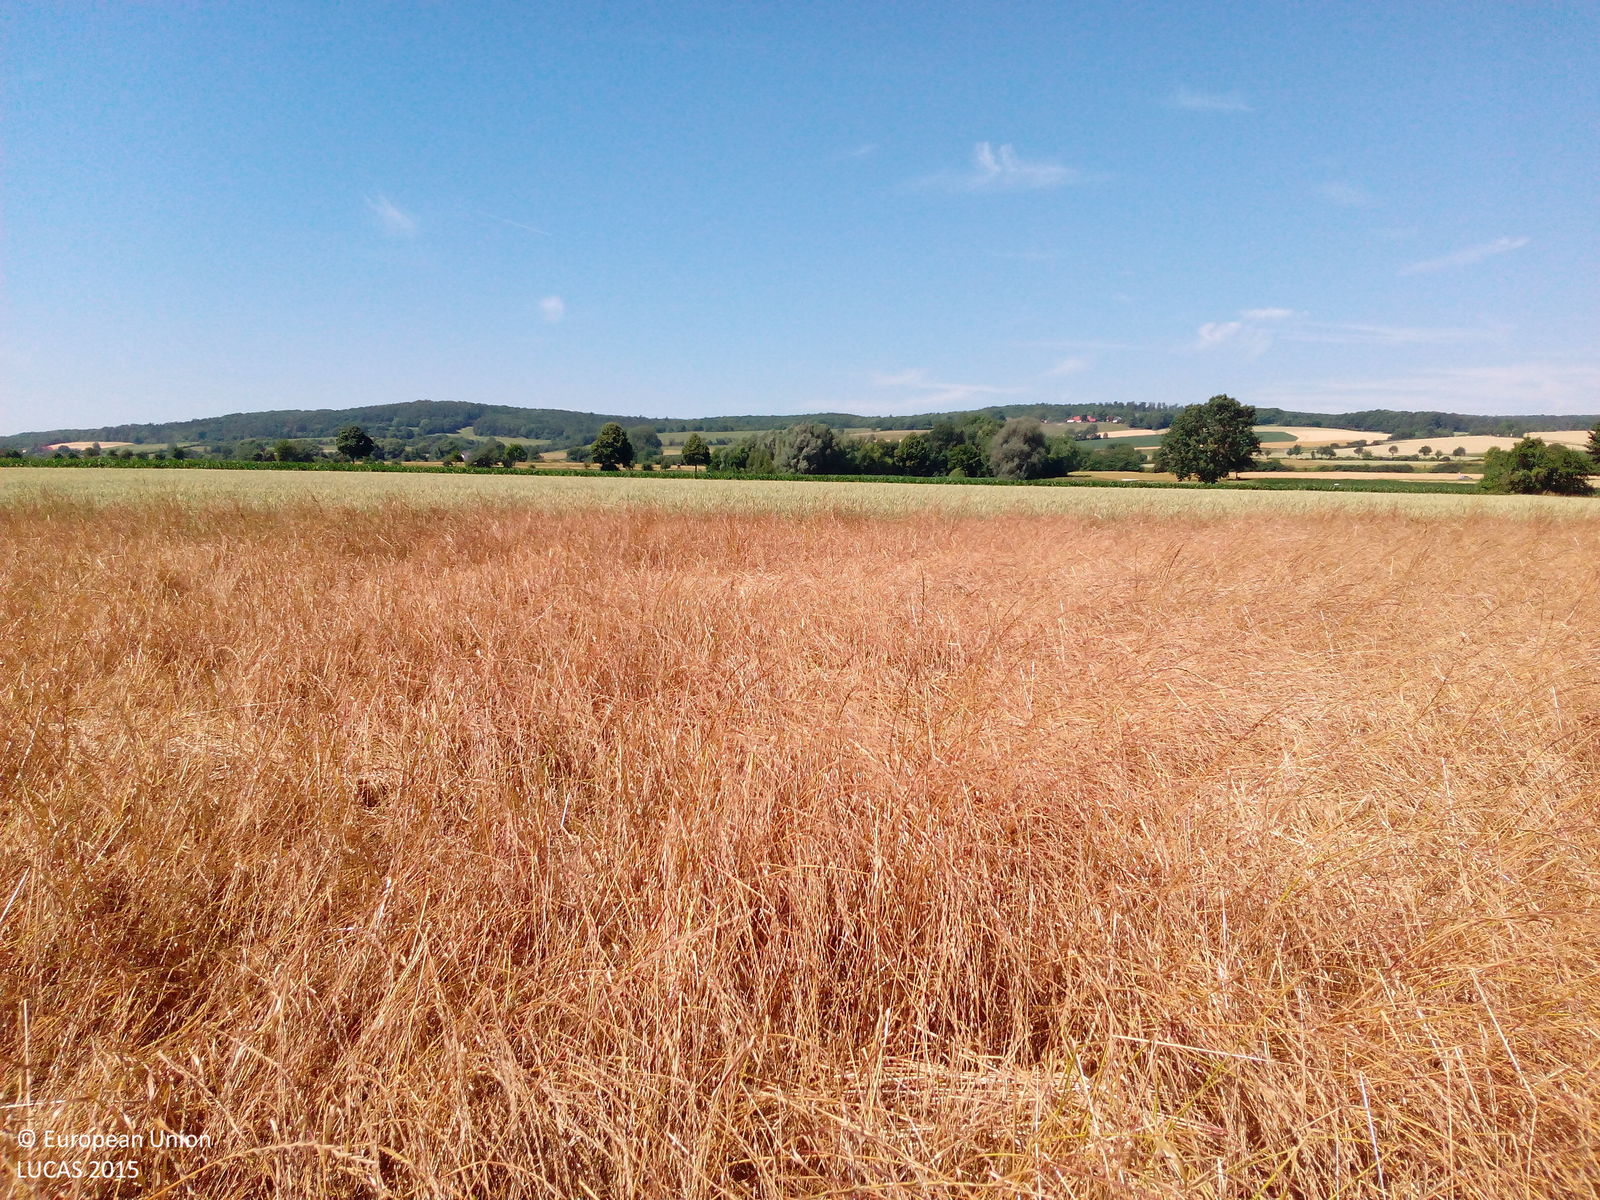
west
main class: Grassland
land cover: Grassland without tree/shrub cover
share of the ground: > 75 %
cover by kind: herbaceous plants 100 %
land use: Agriculture (excluding fallow land and kitchen gardens)
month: July
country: DE
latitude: 51.6764
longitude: 9.8699
